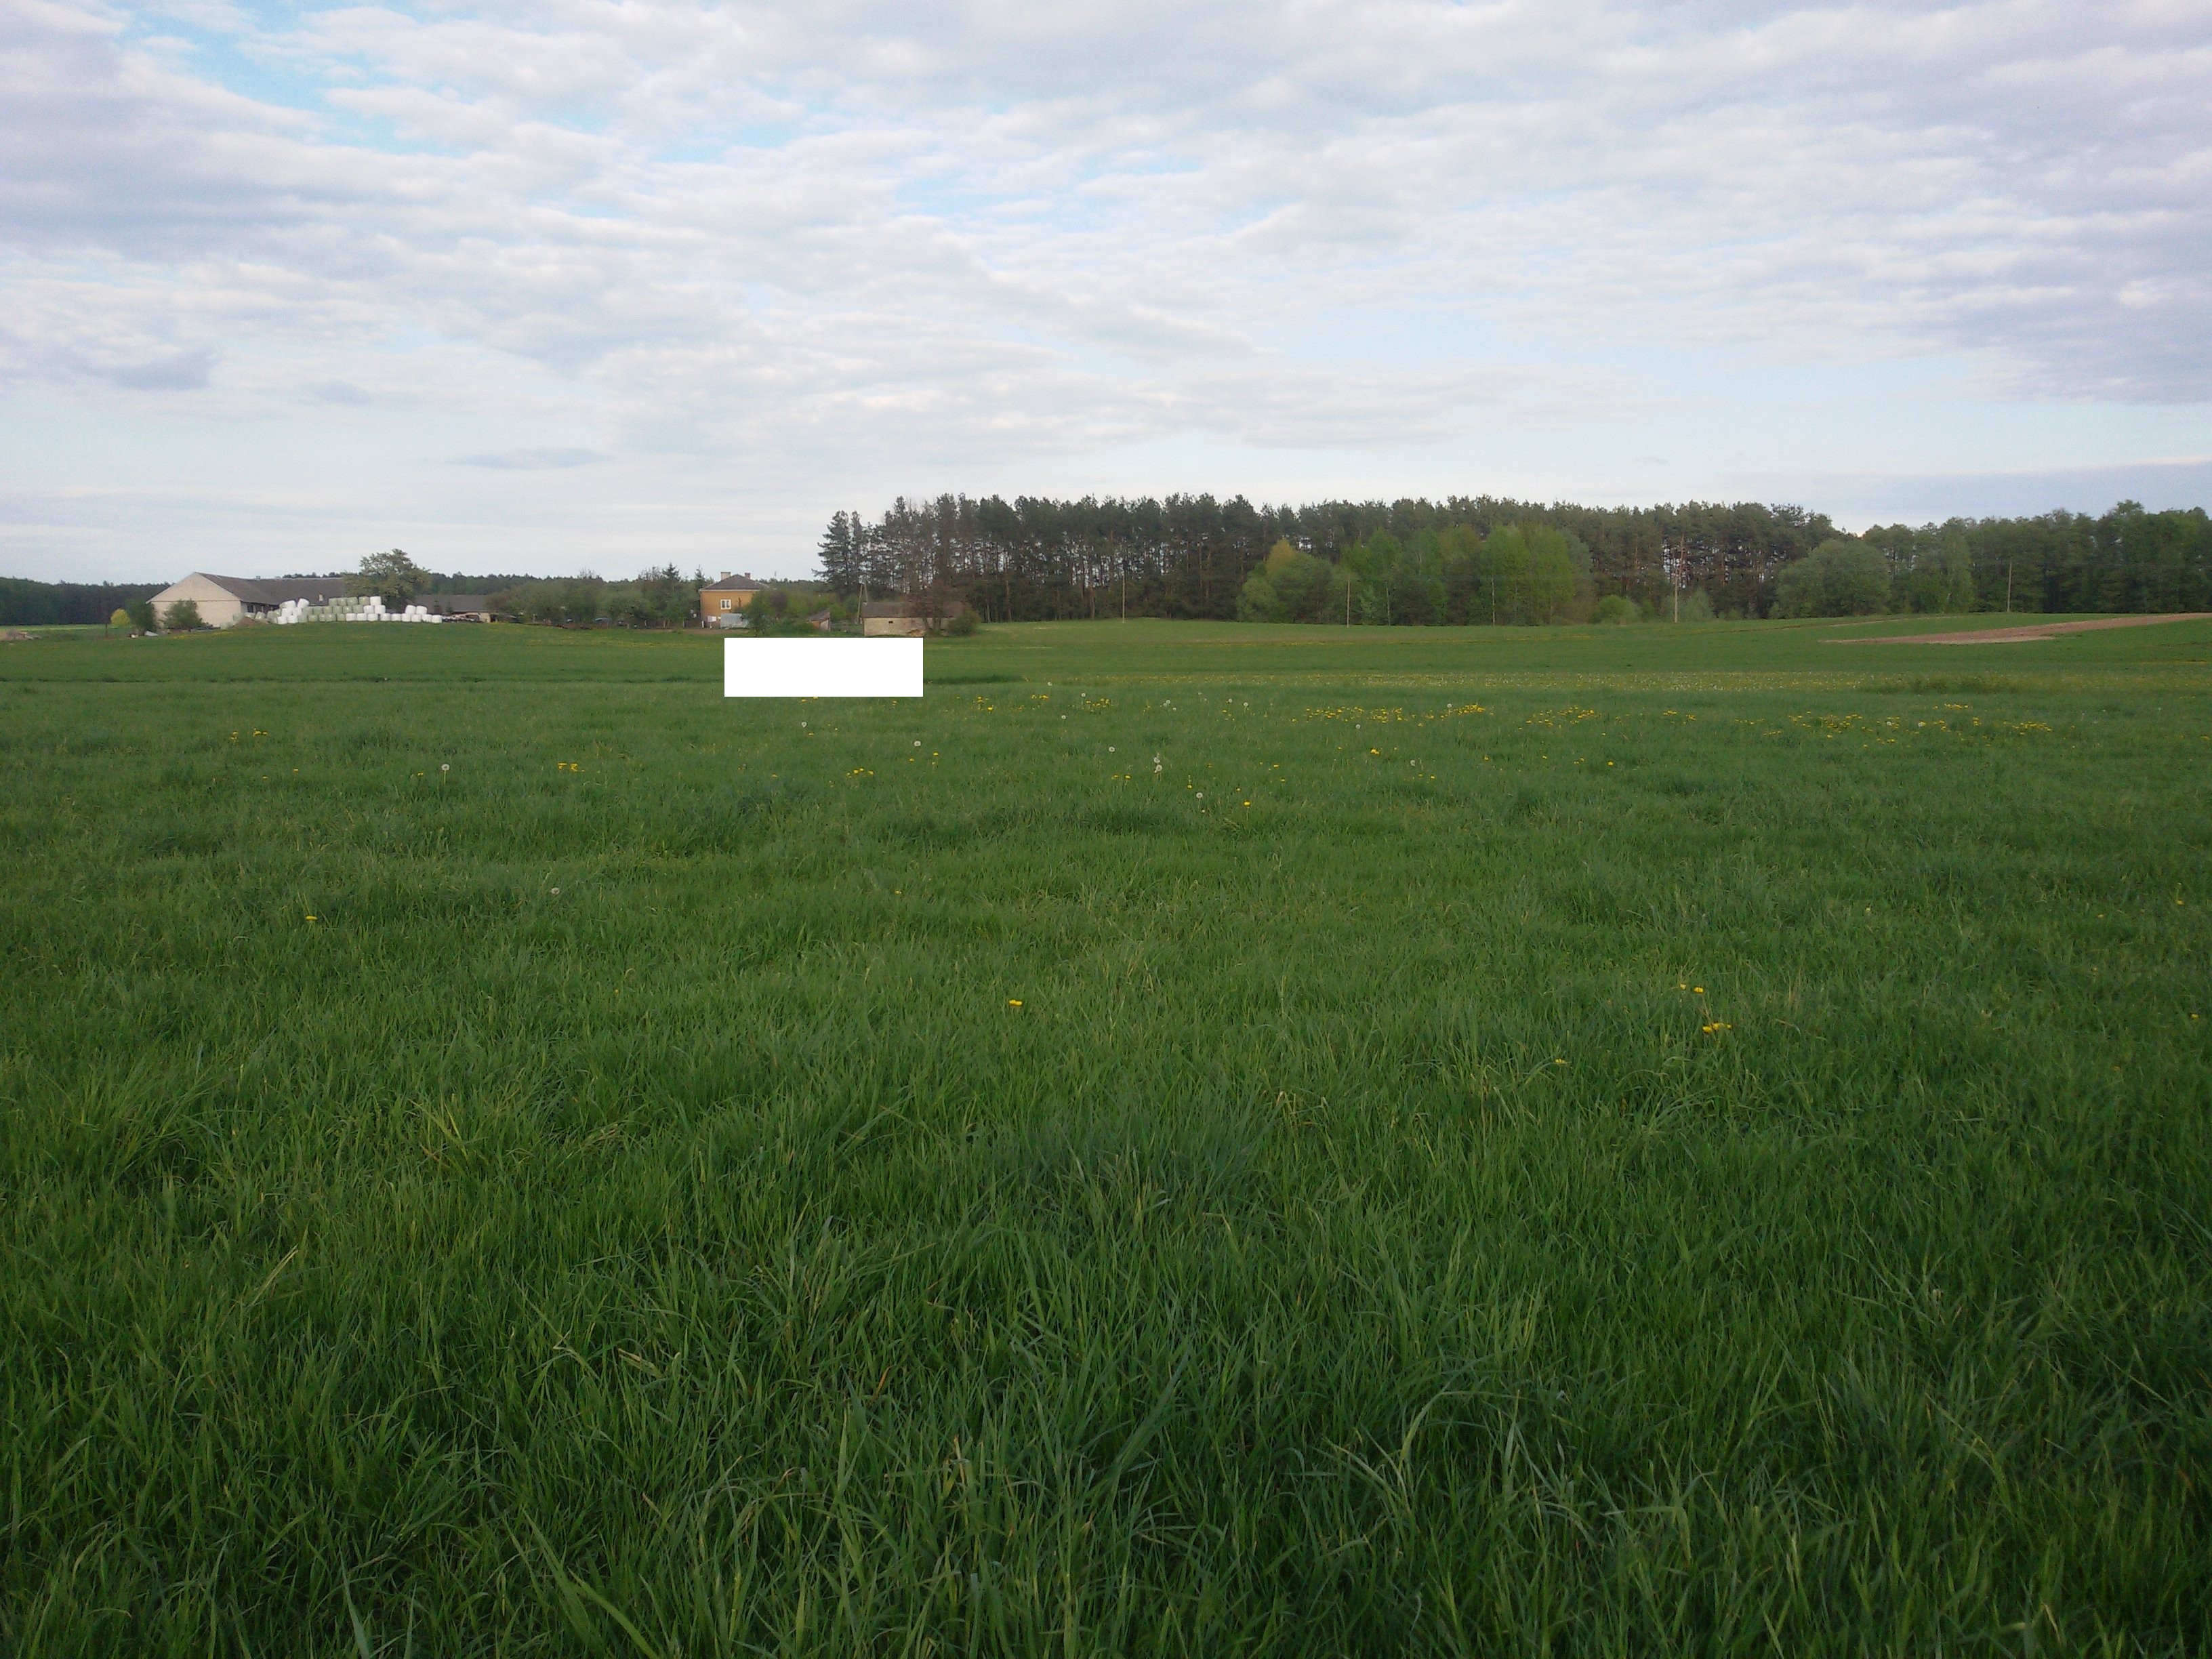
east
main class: Grassland
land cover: Grassland without tree/shrub cover
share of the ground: > 75 %
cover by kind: herbaceous plants 100 %
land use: Agriculture (excluding fallow land and kitchen gardens)
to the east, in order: Grassland without tree/shrub cover; Electric lines; Grassland without tree/shrub cover; Tracks; Grass margins; Strawberries; Oats; Grassland without tree/shrub cover; Ditches and canals; Grassland without tree/shrub cover
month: May
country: PL
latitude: 52.9642
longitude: 22.3765
